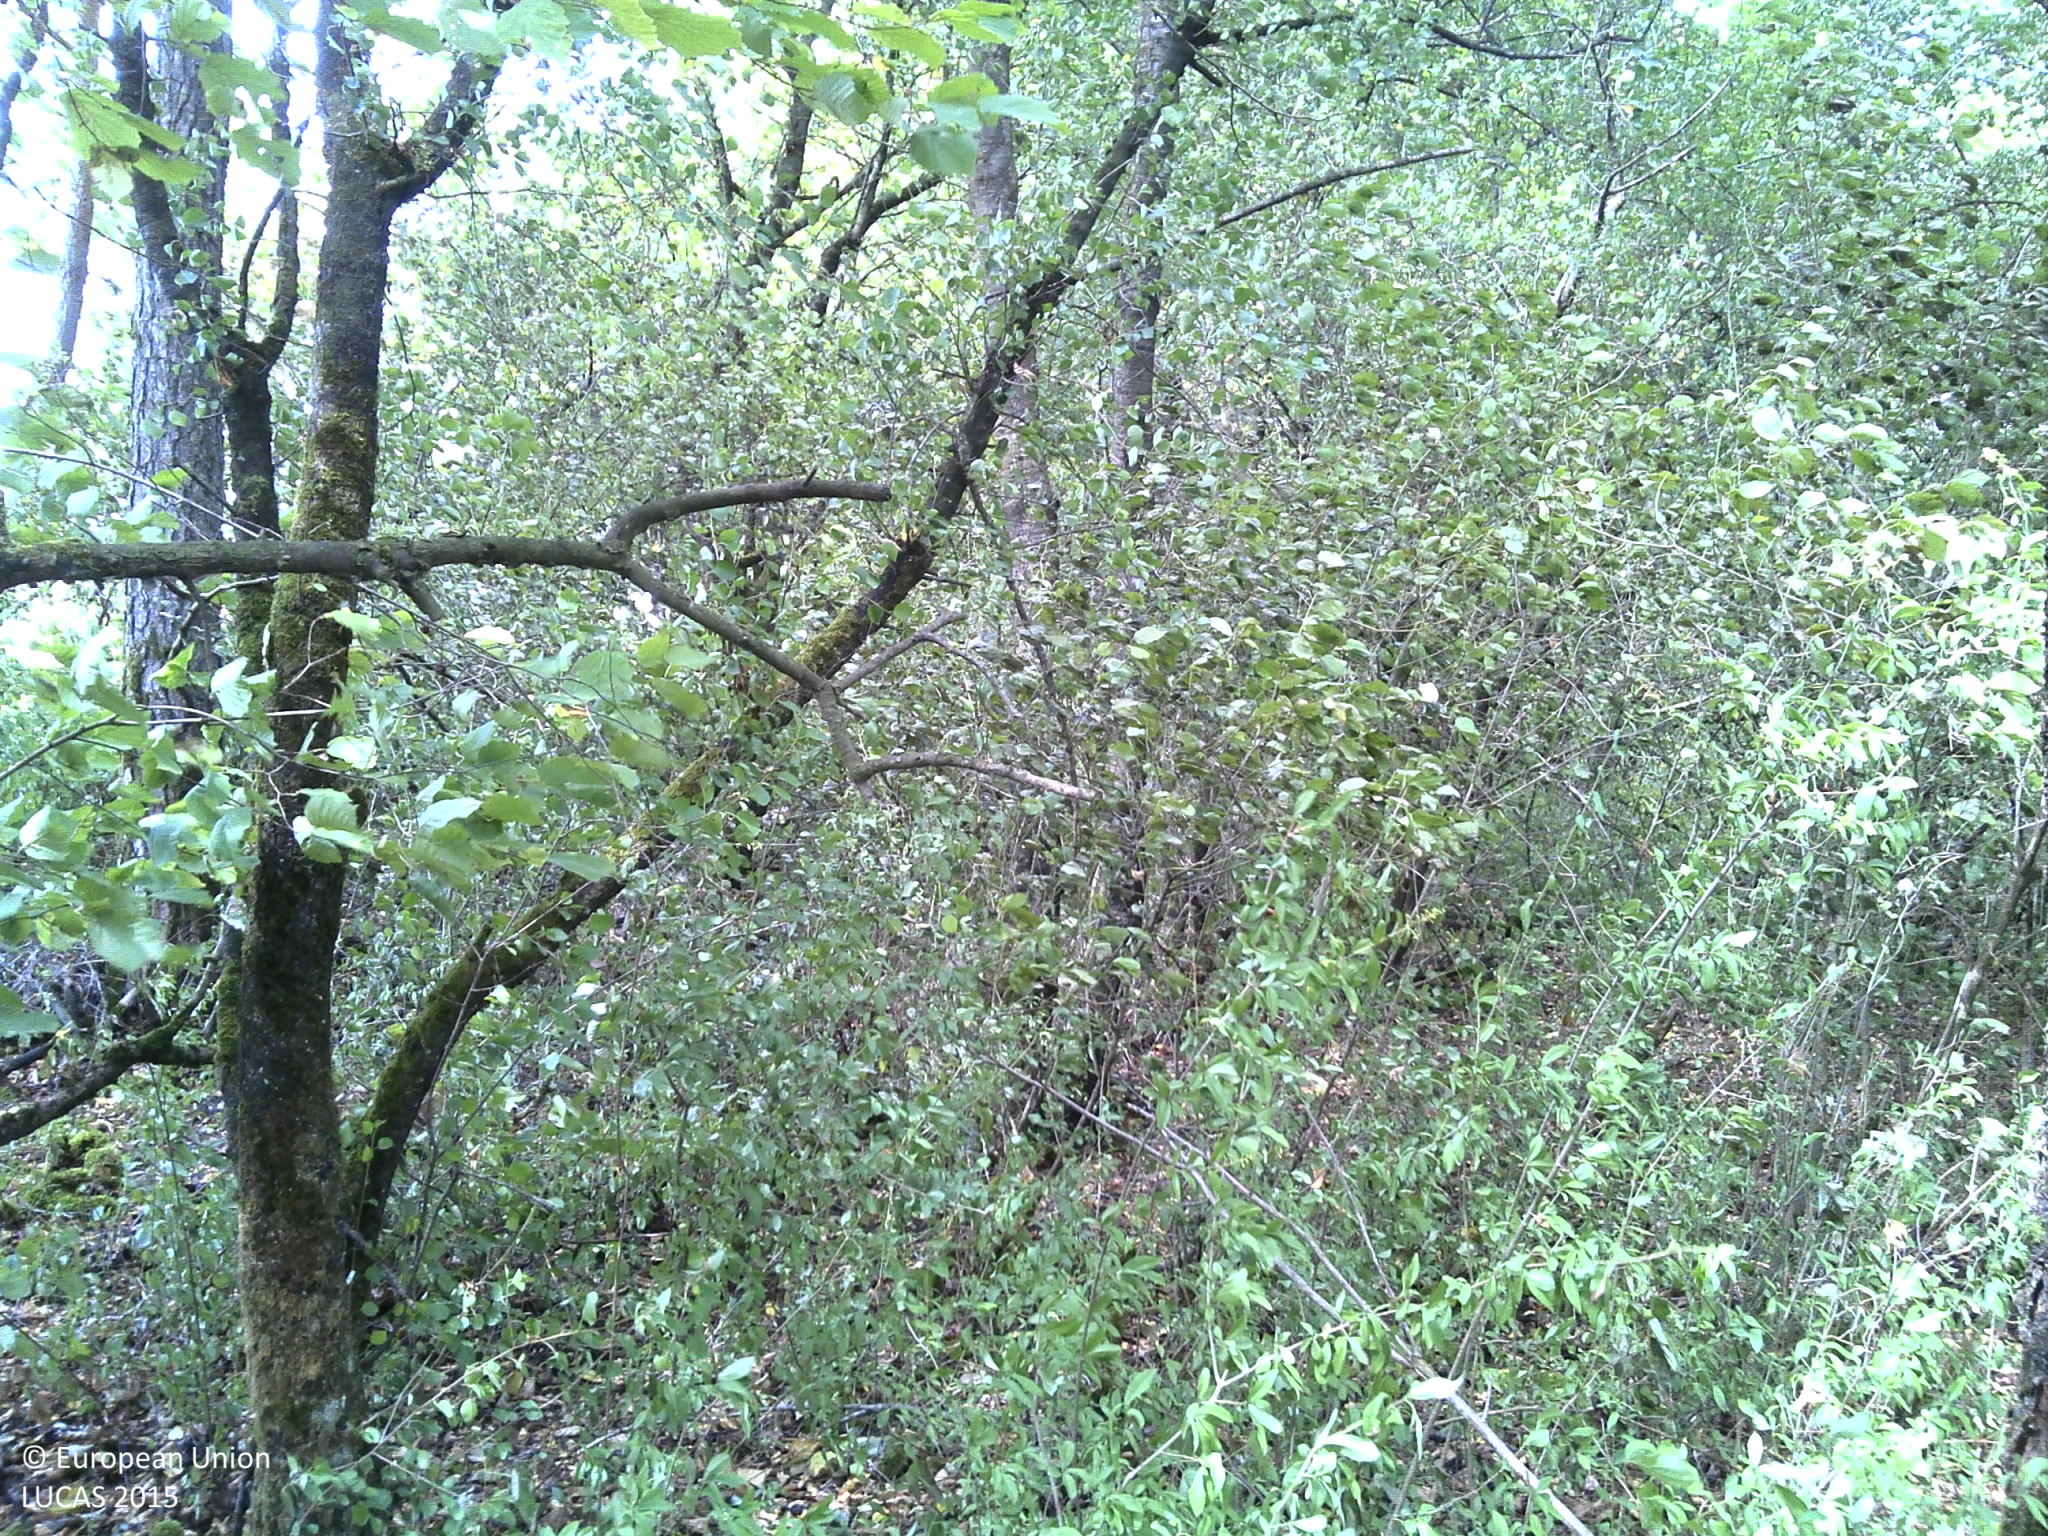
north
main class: Woodland
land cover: Broadleaved woodland
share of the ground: > 75 %
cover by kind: broadleaved forest trees 85 %, coniferous forest trees 10 %, herbaceous plants 5 %
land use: Forestry
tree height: > 5 m
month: August
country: FR
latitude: 48.8659
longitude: 4.5850
